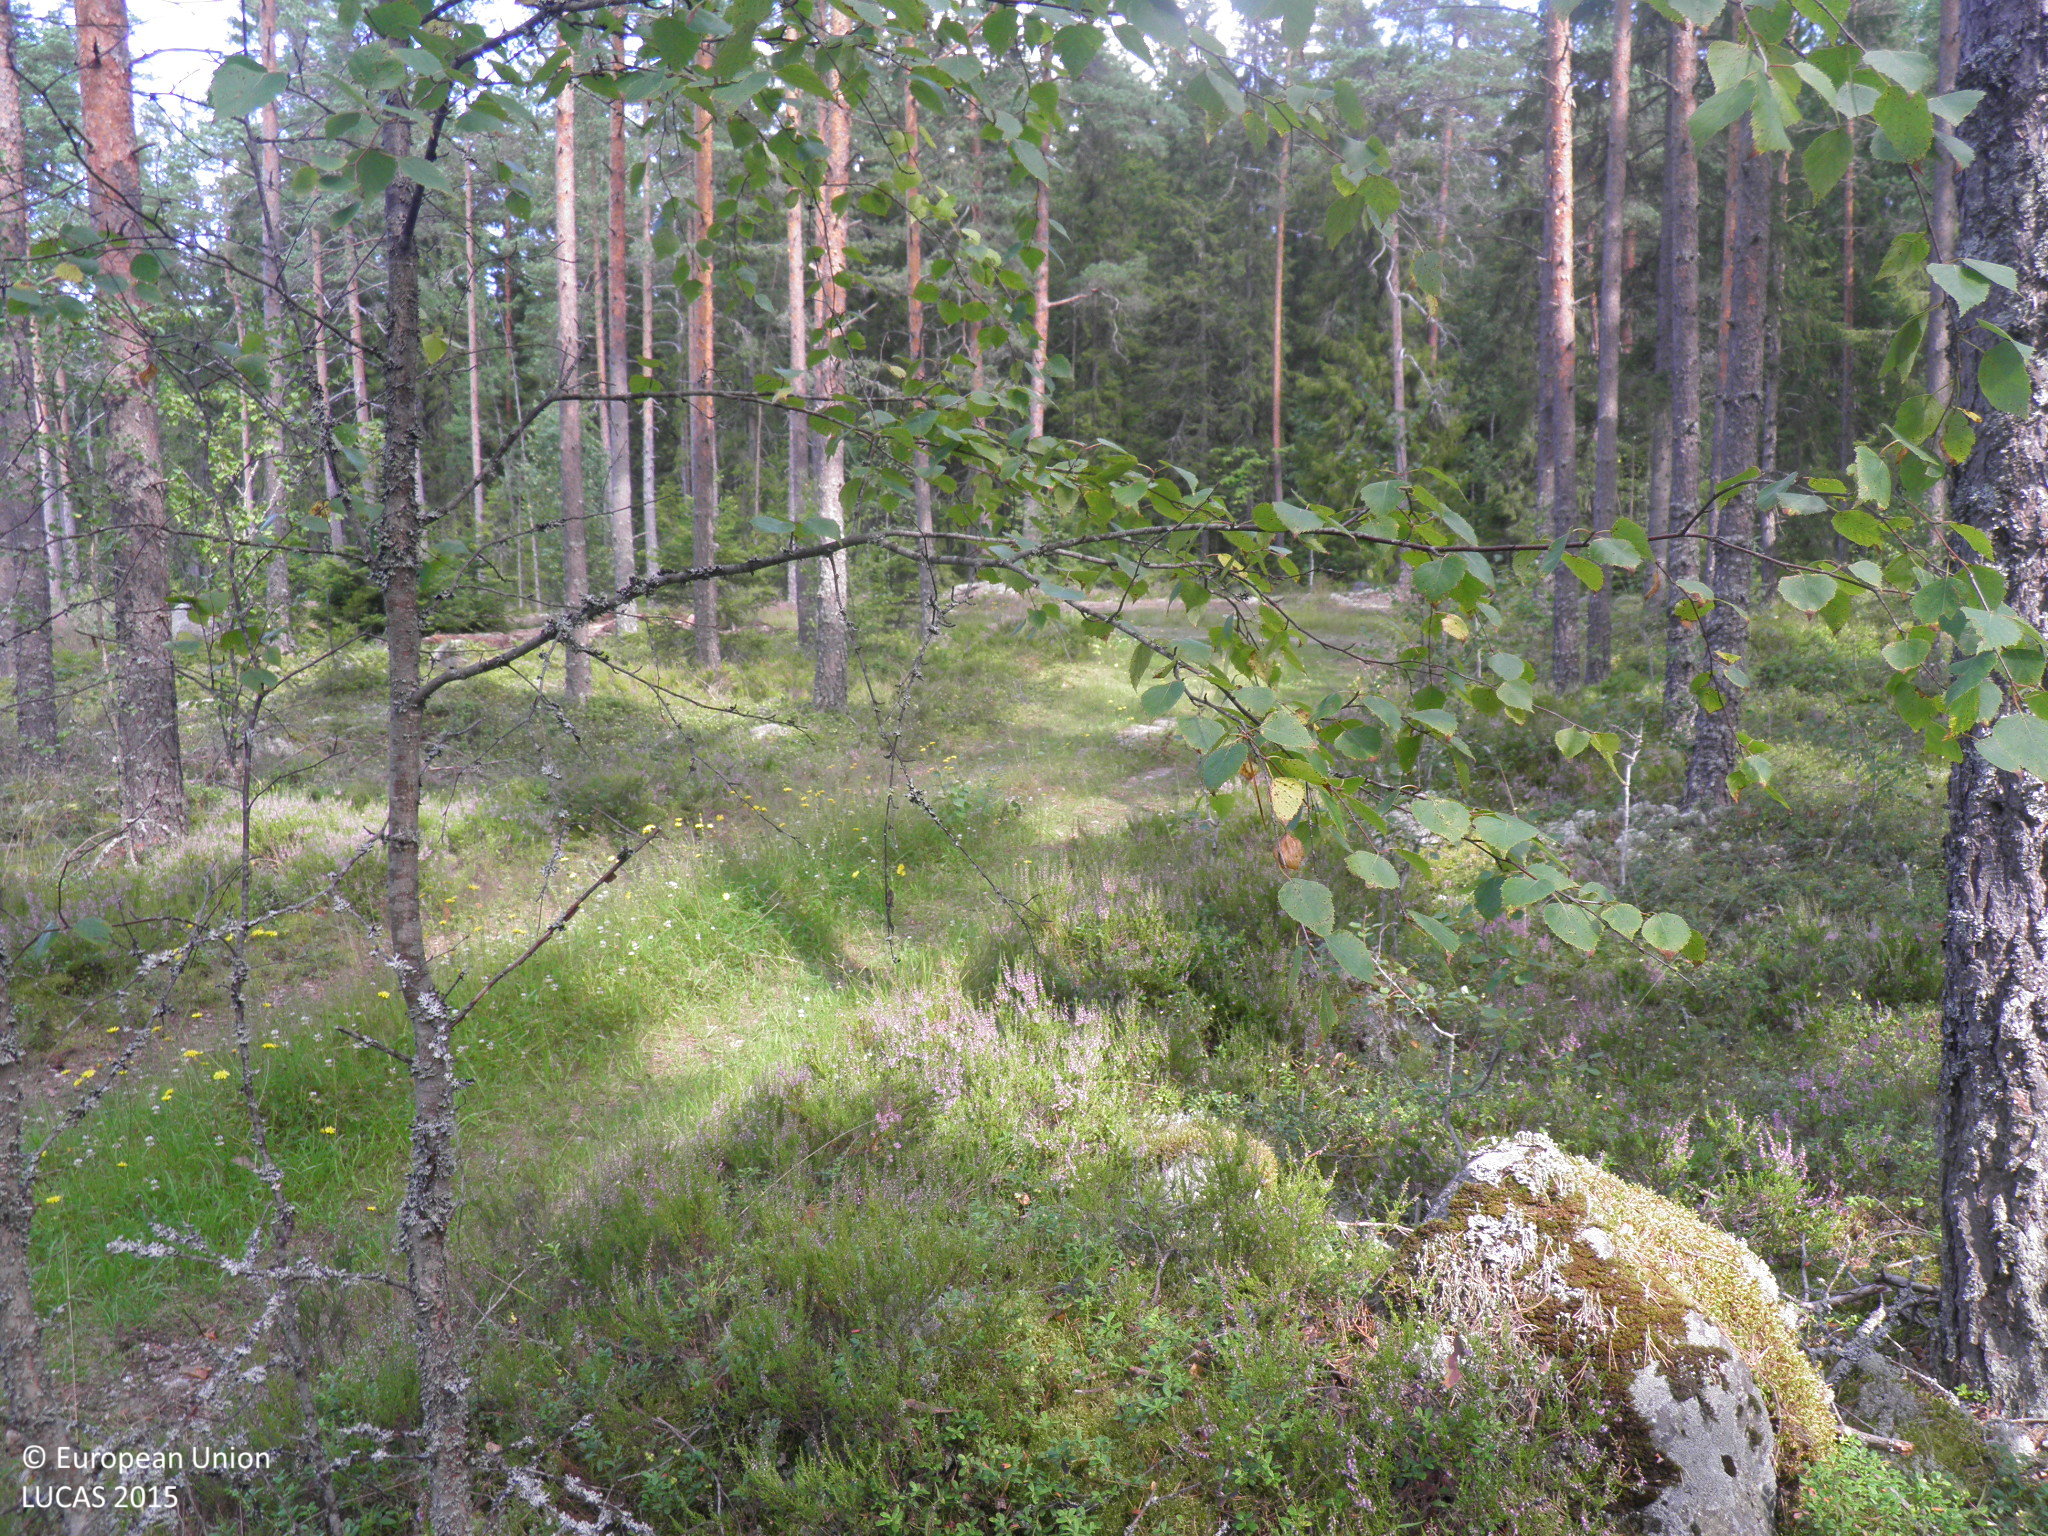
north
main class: Woodland
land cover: Pine dominated coniferous woodland
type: hemiboreal forest and nemoral coniferous forest and mixed broadleaved-coniferous forest
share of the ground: 25 - 50 %
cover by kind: coniferous forest trees 35 %, shrubs 30 %, lichens and mosses 30 %, broadleaved forest trees 5 %
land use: Forestry
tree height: > 5 m
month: August
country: FI
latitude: 61.0286
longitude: 22.0721
